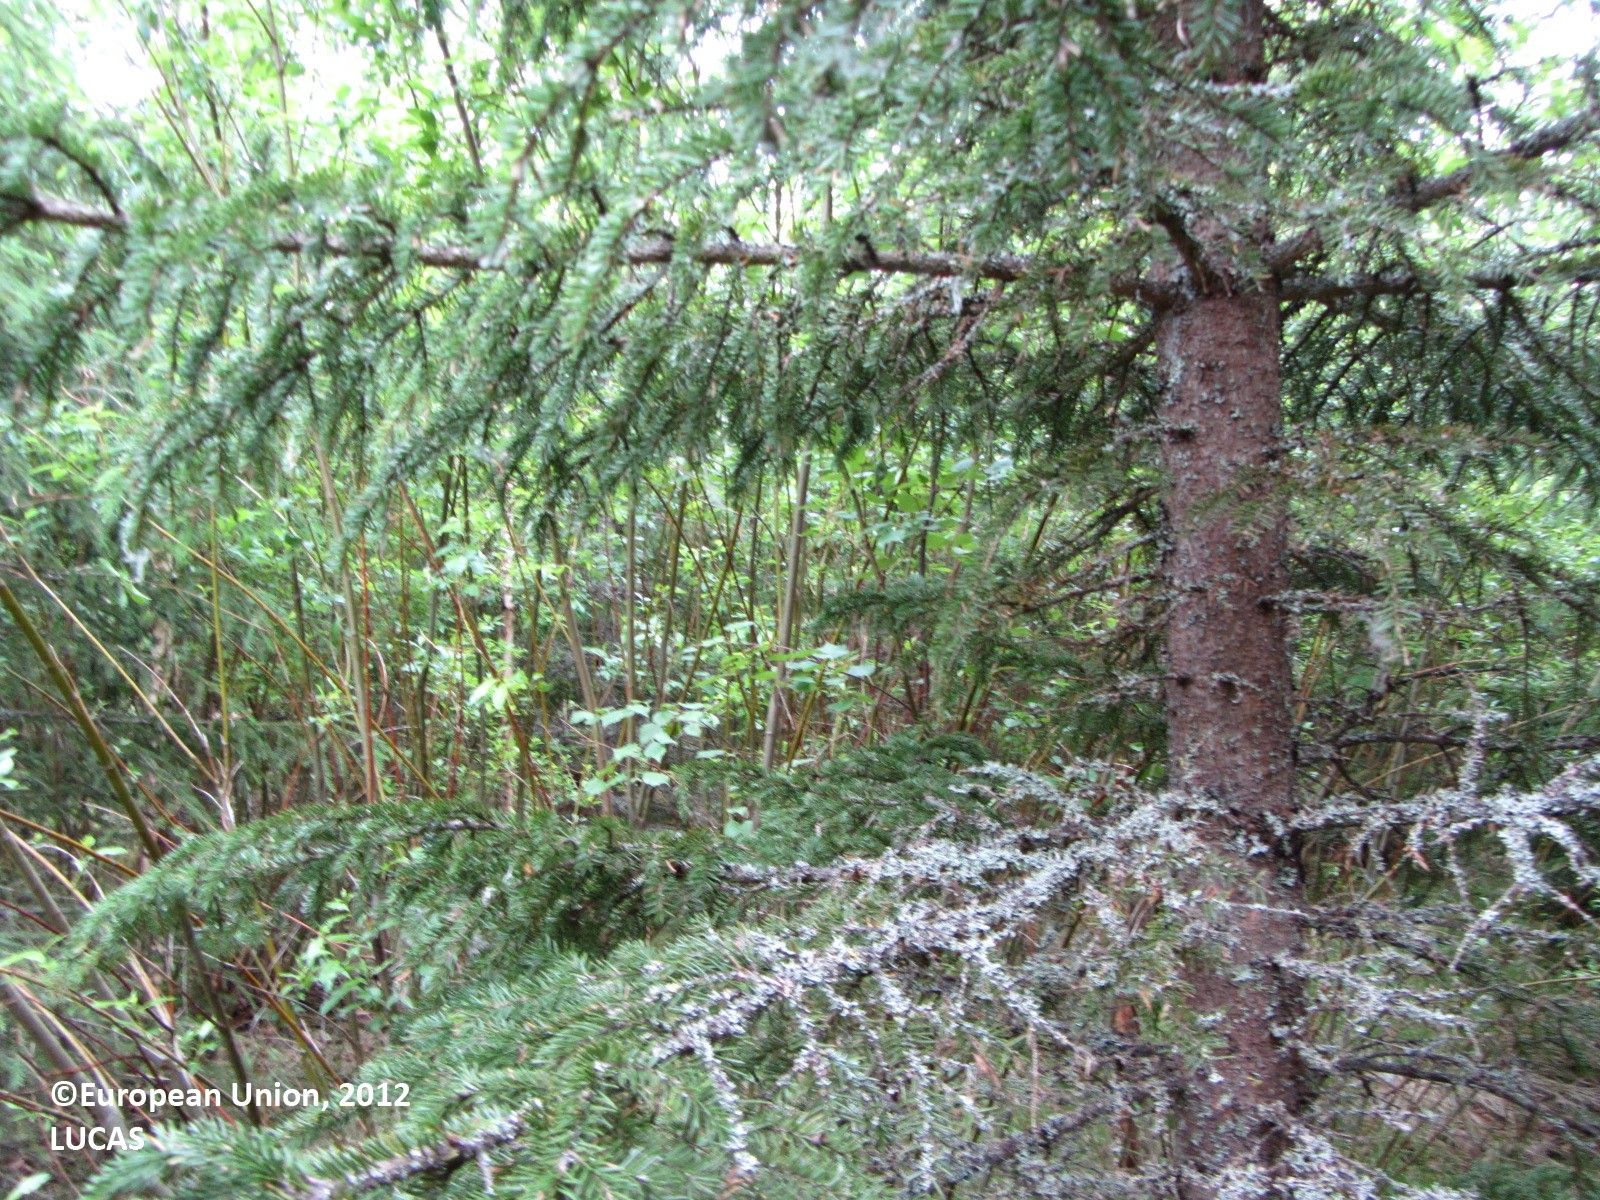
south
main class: Woodland
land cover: Spruce dominated mixed woodland
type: boreal forest
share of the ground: > 75 %
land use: Forestry
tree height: > 5 m
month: June
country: FI
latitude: 62.6211
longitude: 25.6090
